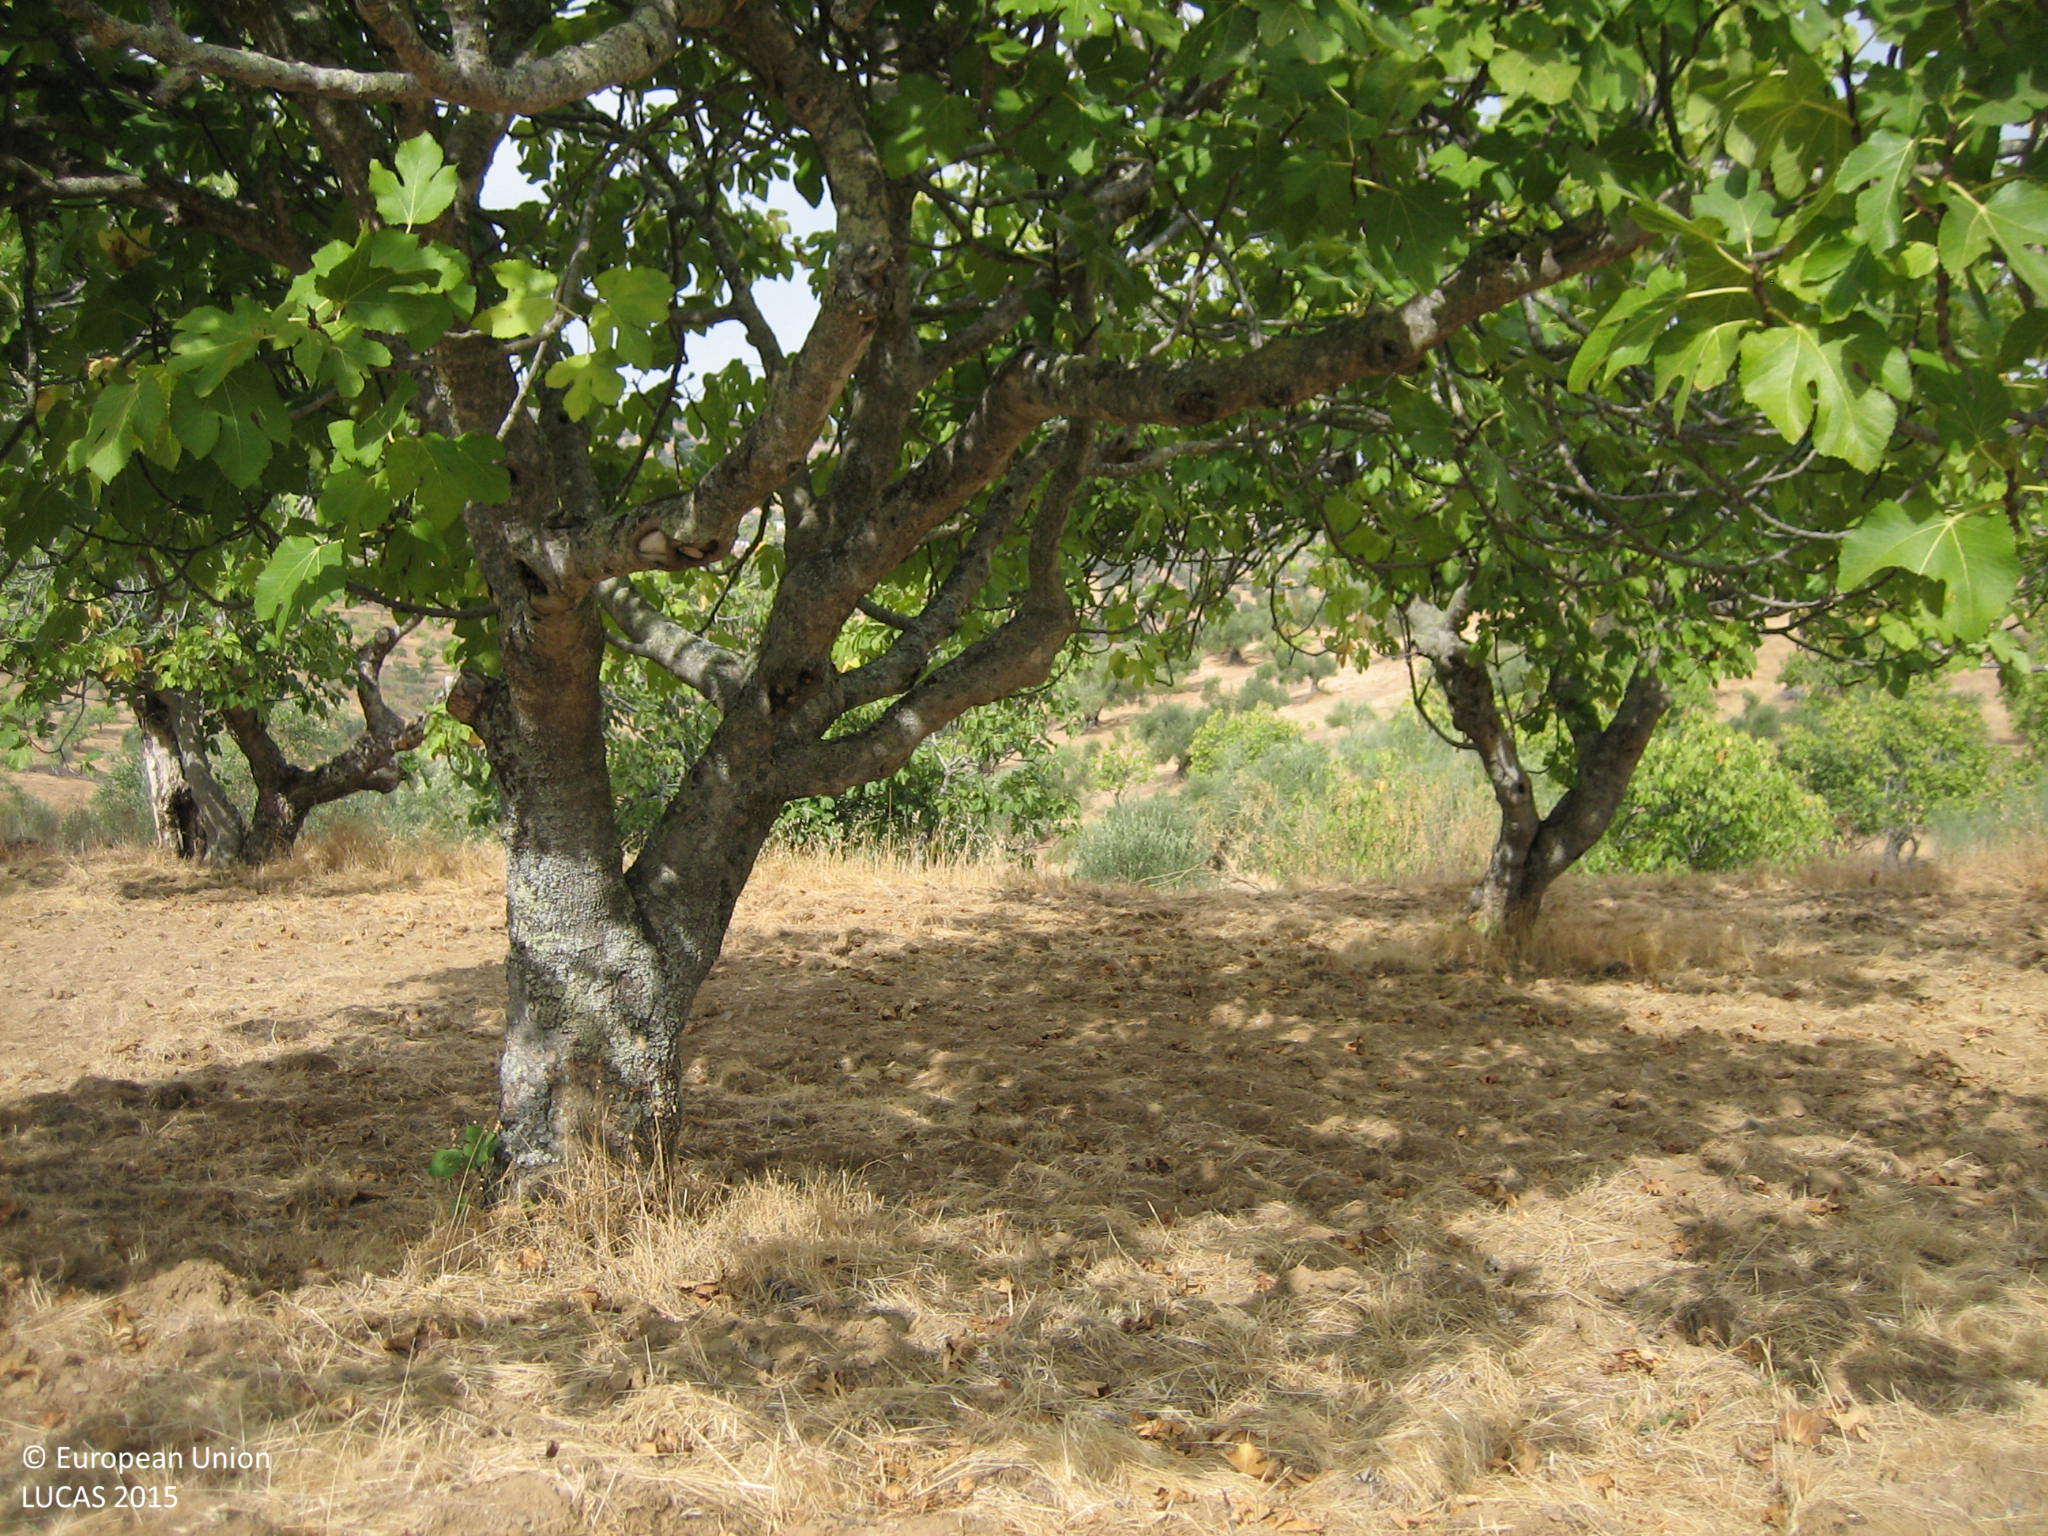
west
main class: Cropland
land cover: Other fruit trees and berries
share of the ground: 25 - 50 %
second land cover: Other bare soil
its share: > 75 %
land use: Agriculture (excluding fallow land and kitchen gardens)
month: September
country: ES
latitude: 38.5173
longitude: -6.7695
